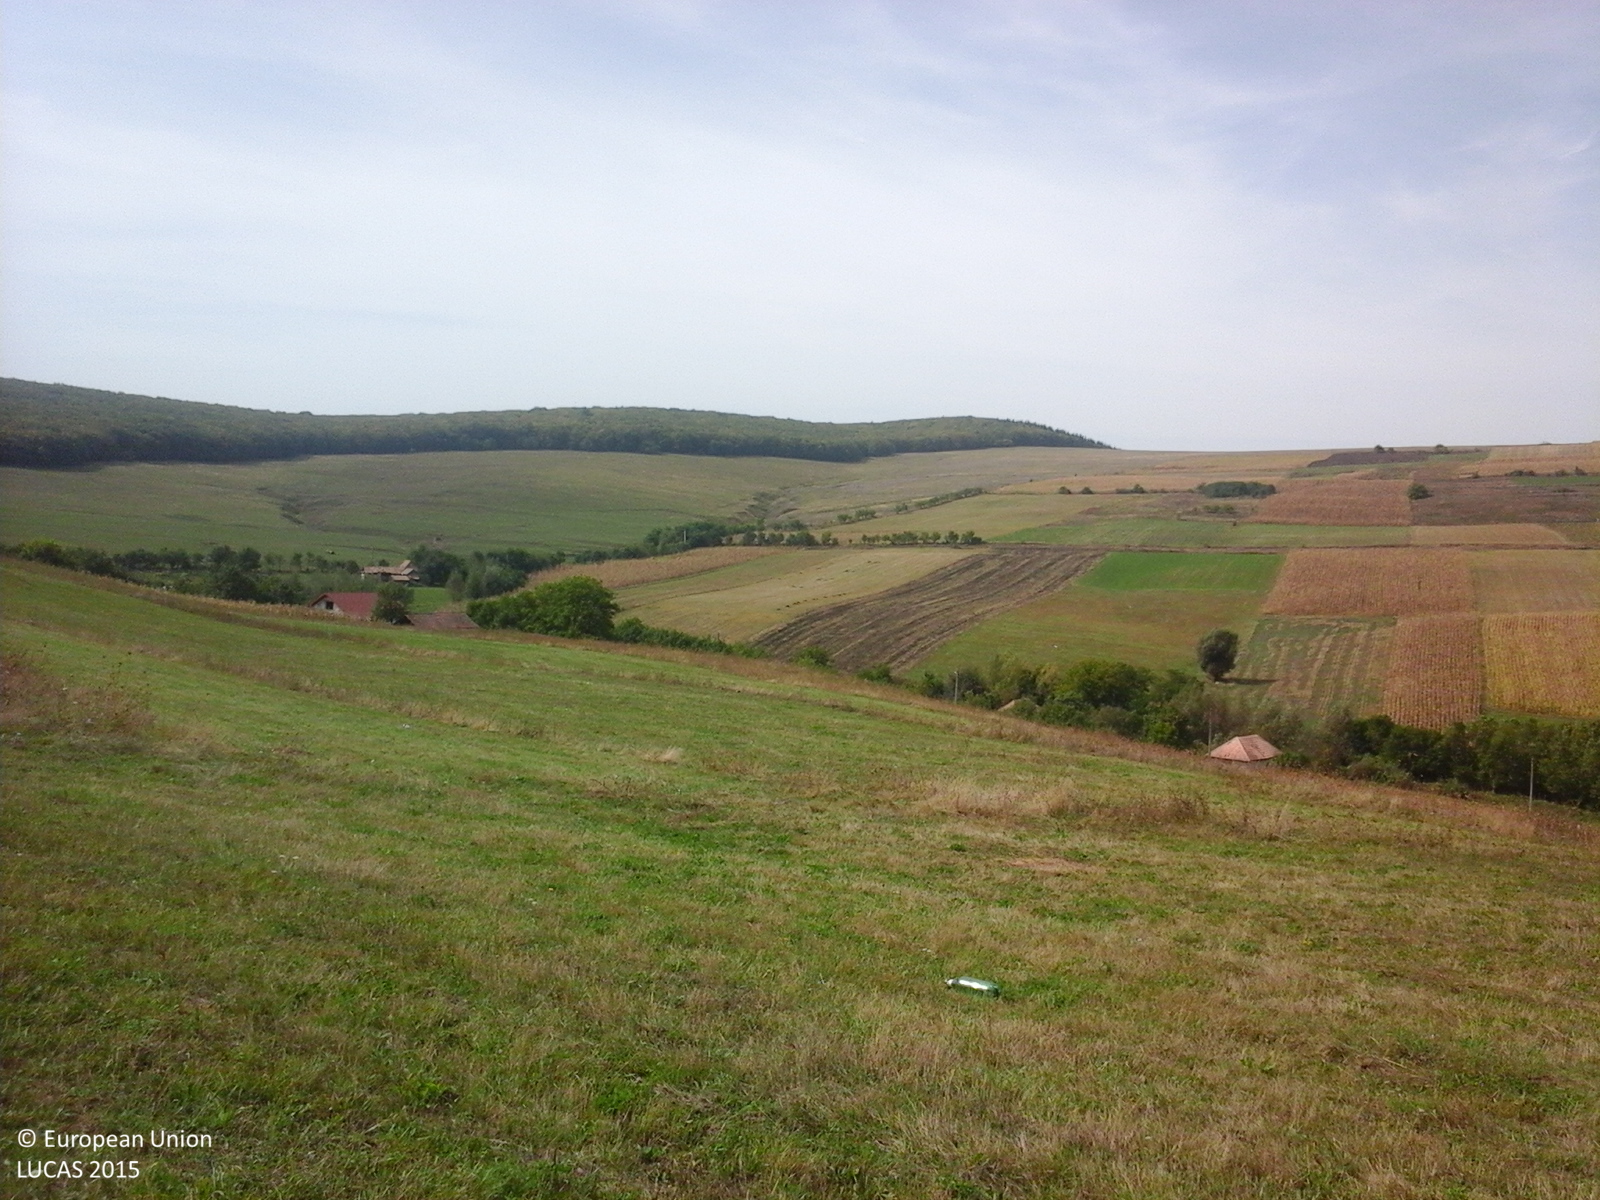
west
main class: Grassland
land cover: Grassland without tree/shrub cover
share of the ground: > 75 %
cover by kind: herbaceous plants 100 %
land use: Agriculture (excluding fallow land and kitchen gardens)
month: September
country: RO
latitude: 46.9007
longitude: 24.1679
